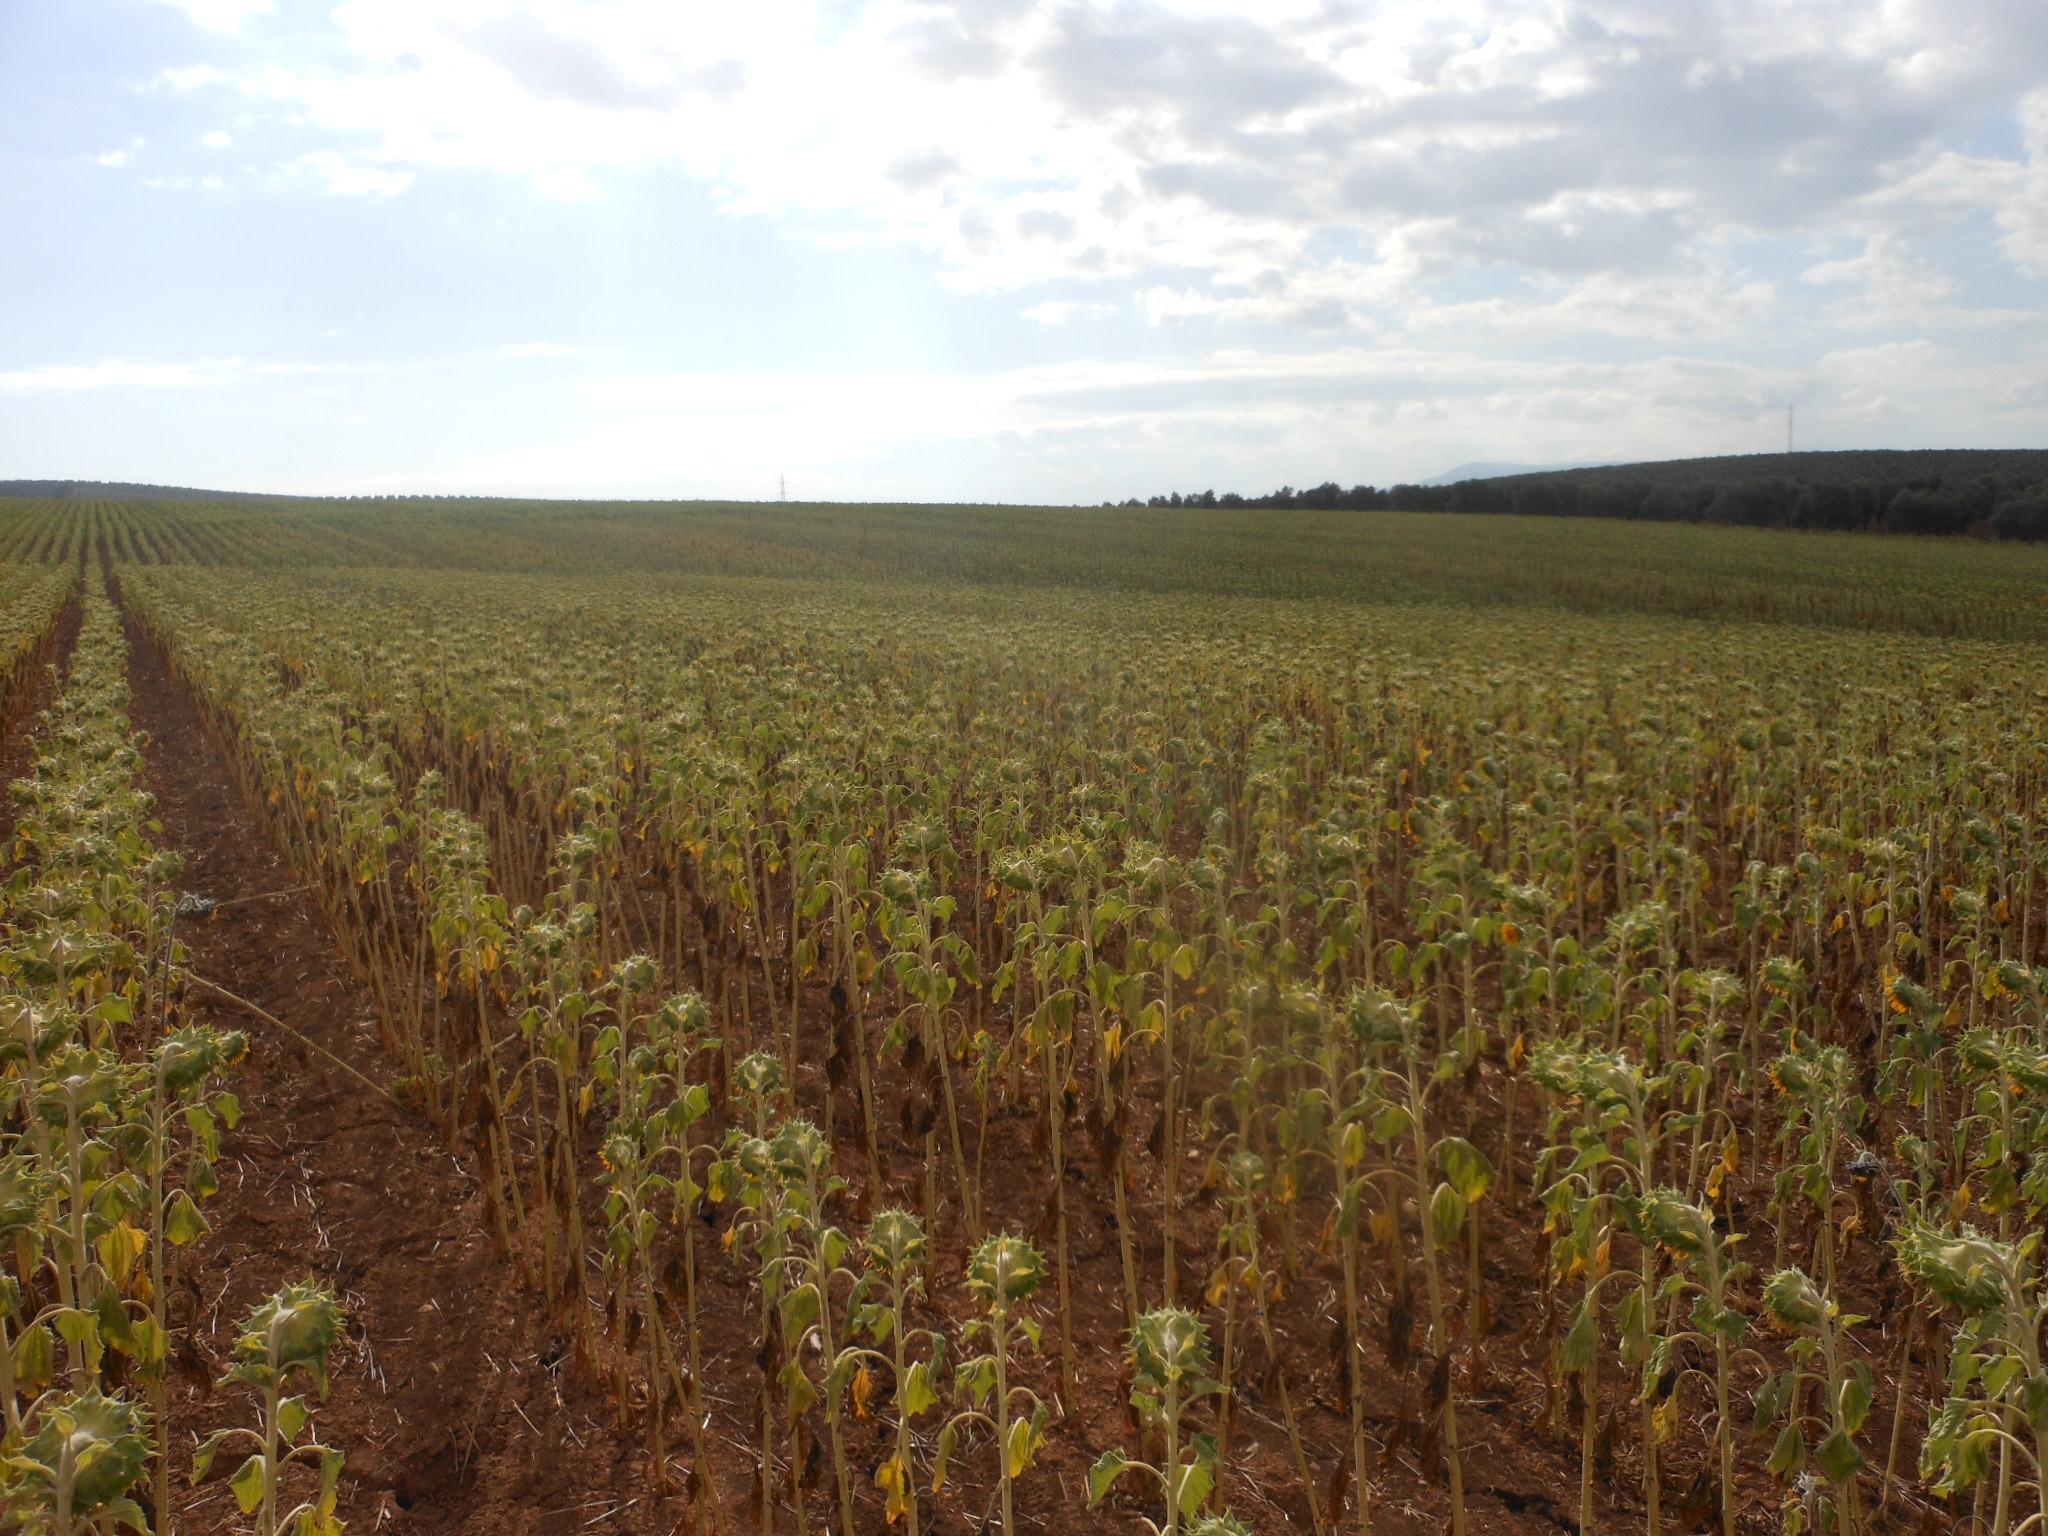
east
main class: Cropland
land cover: Sunflower
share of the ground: 50 - 75 %
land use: Agriculture (excluding fallow land and kitchen gardens)
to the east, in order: Sunflower
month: June
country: ES
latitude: 37.3298
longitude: -5.0755
